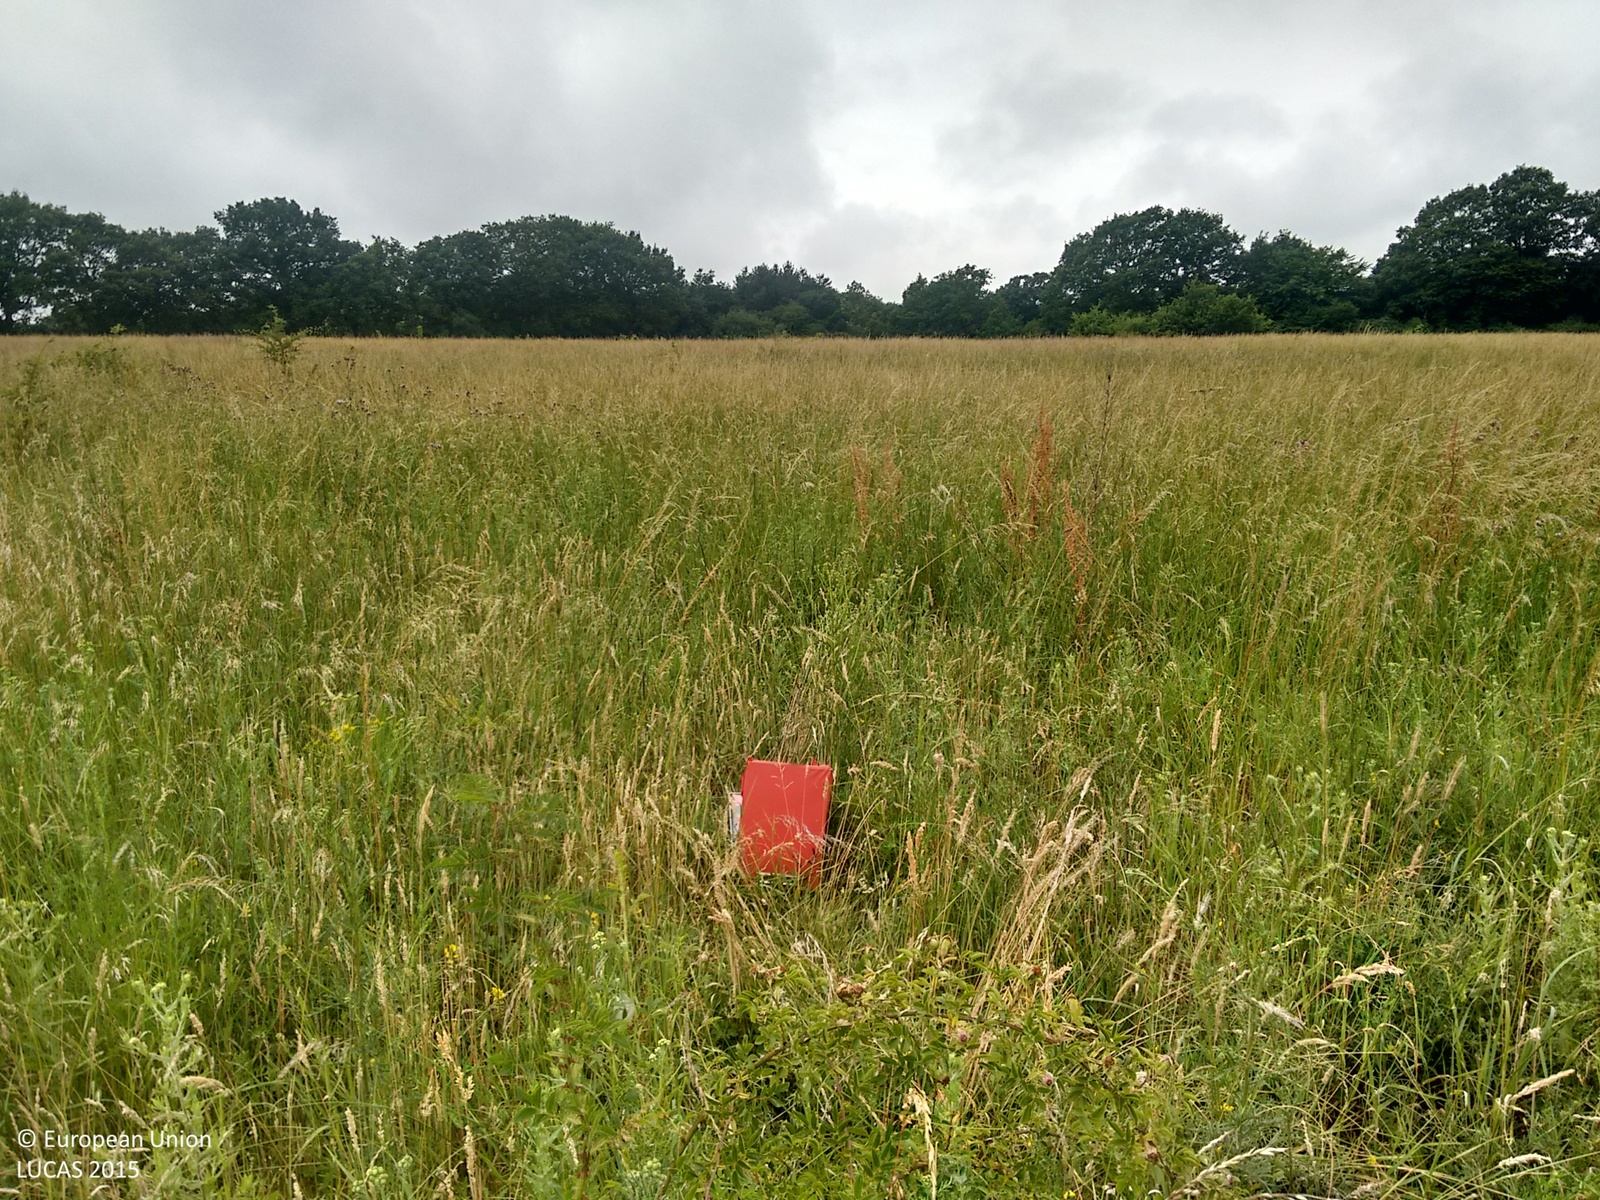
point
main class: Grassland
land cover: Grassland without tree/shrub cover
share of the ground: > 75 %
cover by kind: herbaceous plants 100 %
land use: Agriculture (excluding fallow land and kitchen gardens)
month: July
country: GB
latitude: 51.6474
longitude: 0.4476
